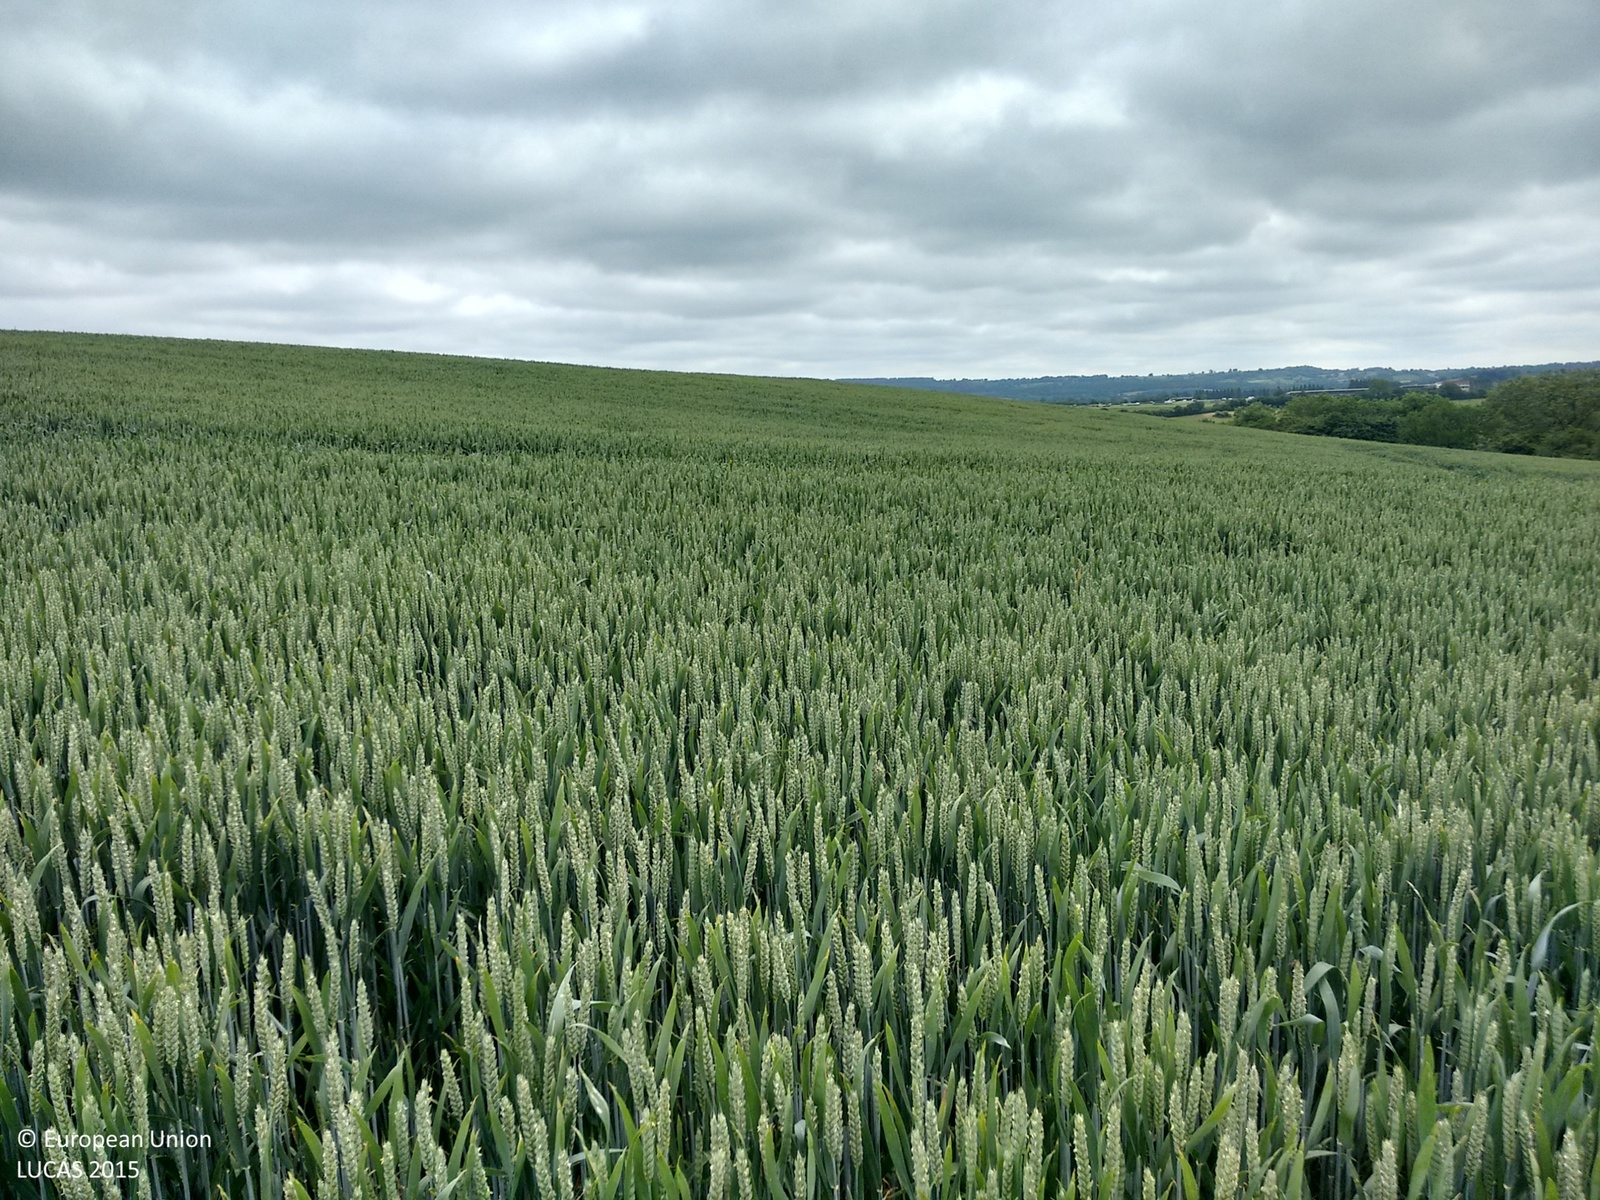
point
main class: Cropland
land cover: Common wheat
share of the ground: > 75 %
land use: Agriculture (excluding fallow land and kitchen gardens)
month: June
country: GB
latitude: 51.0651
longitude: -2.4371
